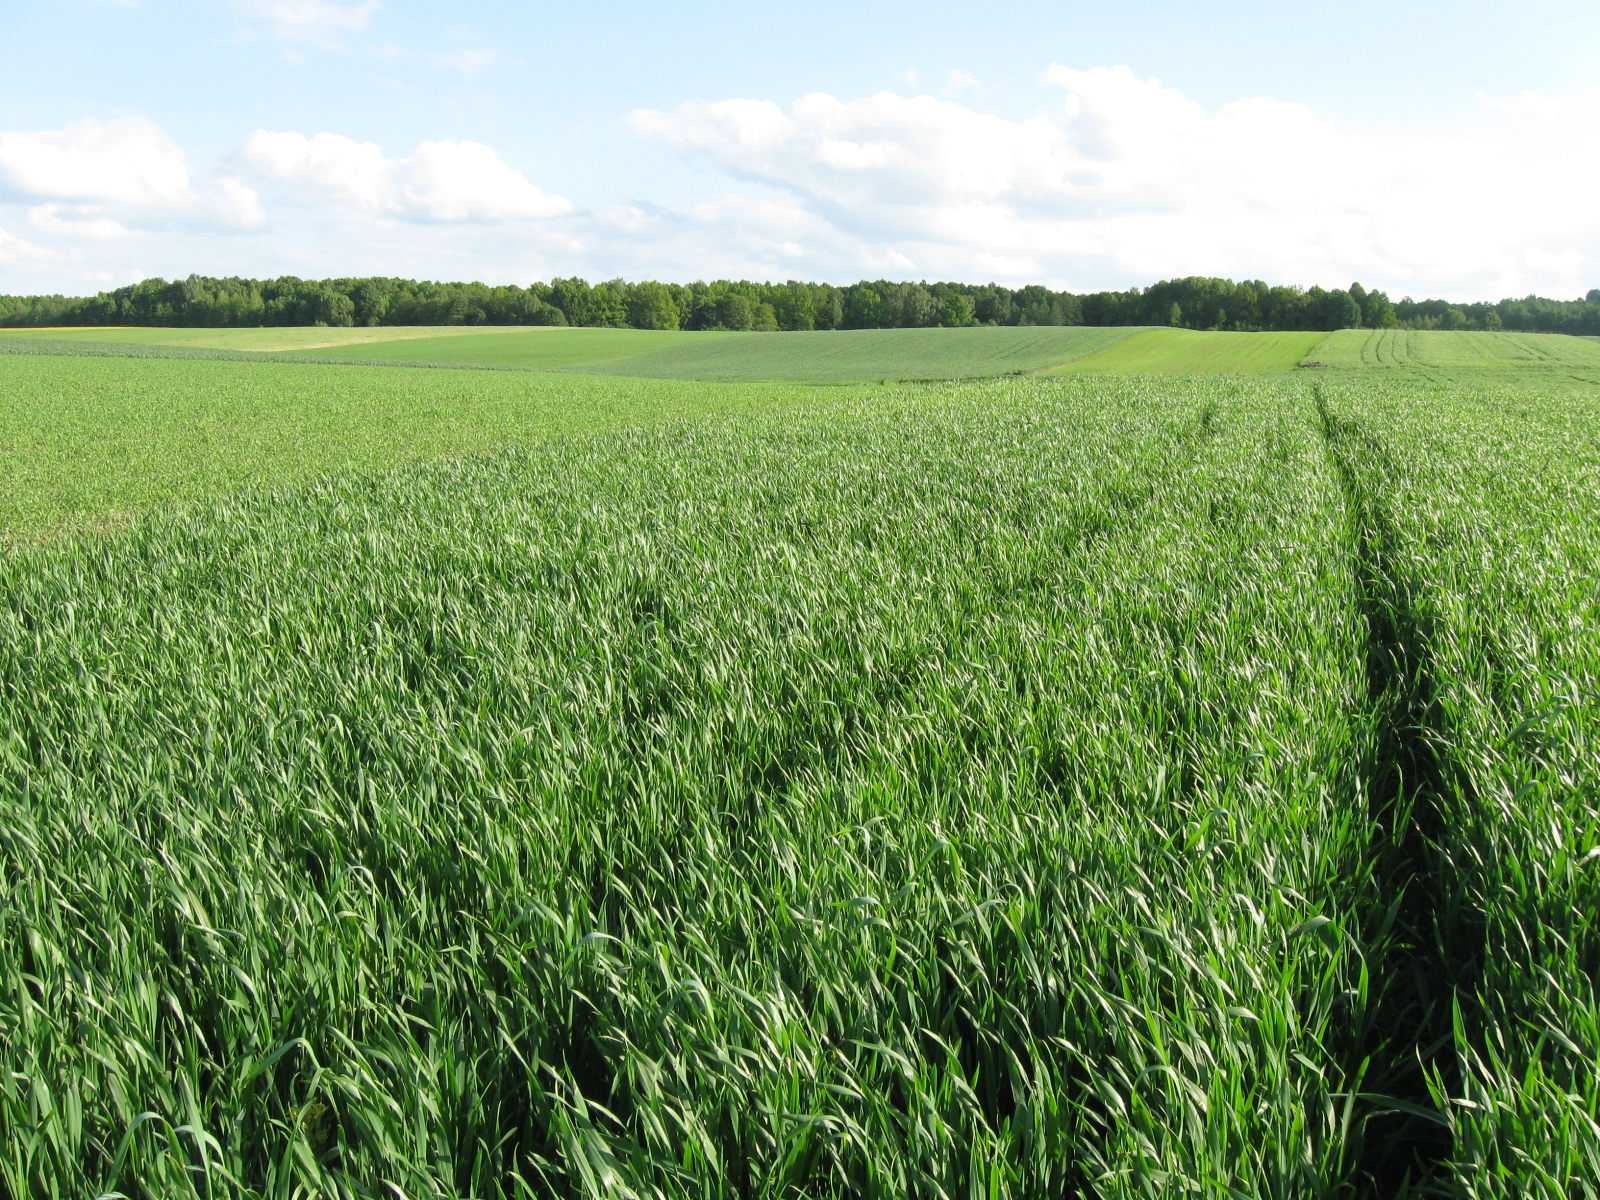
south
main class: Cropland
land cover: Common wheat
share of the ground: > 75 %
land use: Agriculture (excluding fallow land and kitchen gardens)
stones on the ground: < 10 %
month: May
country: LT
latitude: 54.6125
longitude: 22.8122
